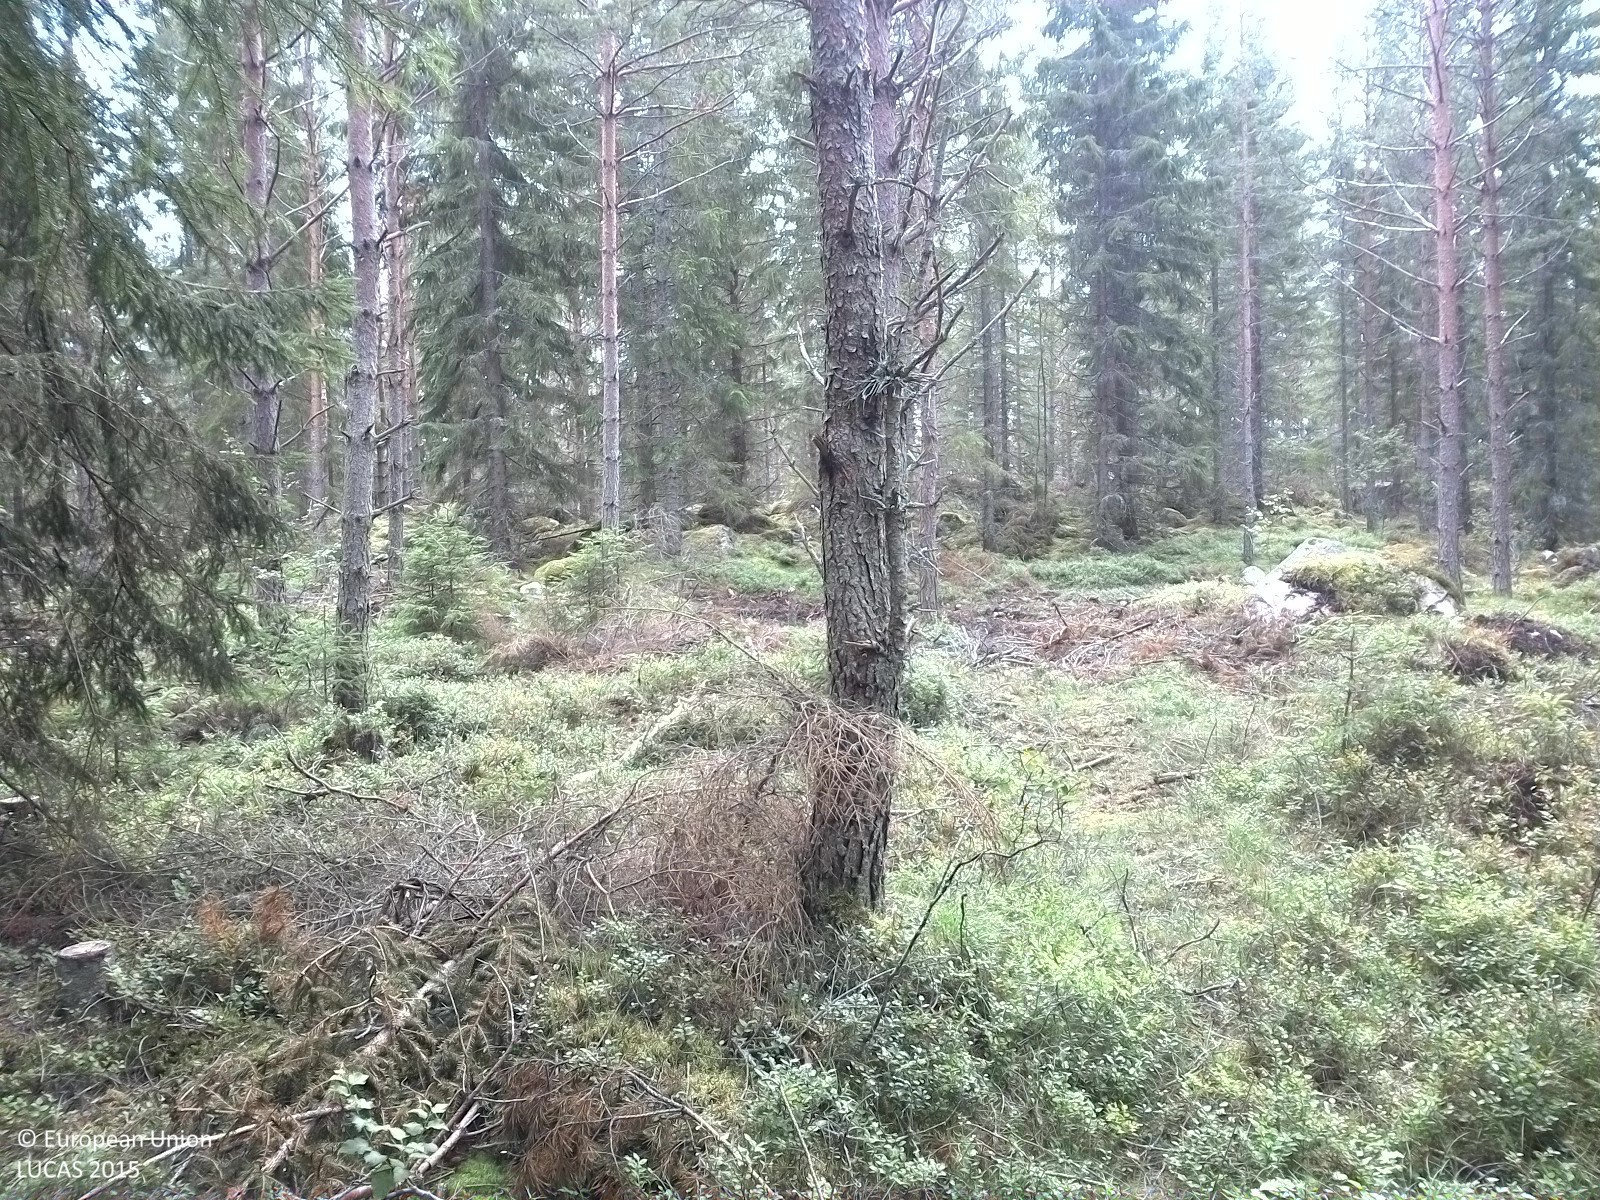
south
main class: Woodland
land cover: Pine dominated mixed woodland
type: boreal forest
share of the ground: 25 - 50 %
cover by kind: herbaceous plants 35 %, coniferous forest trees 25 %, lichens and mosses 20 %, broadleaved forest trees 15 %, shrubs 5 %
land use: Forestry
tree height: > 5 m
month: August
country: SE
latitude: 58.9242
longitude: 15.3599
